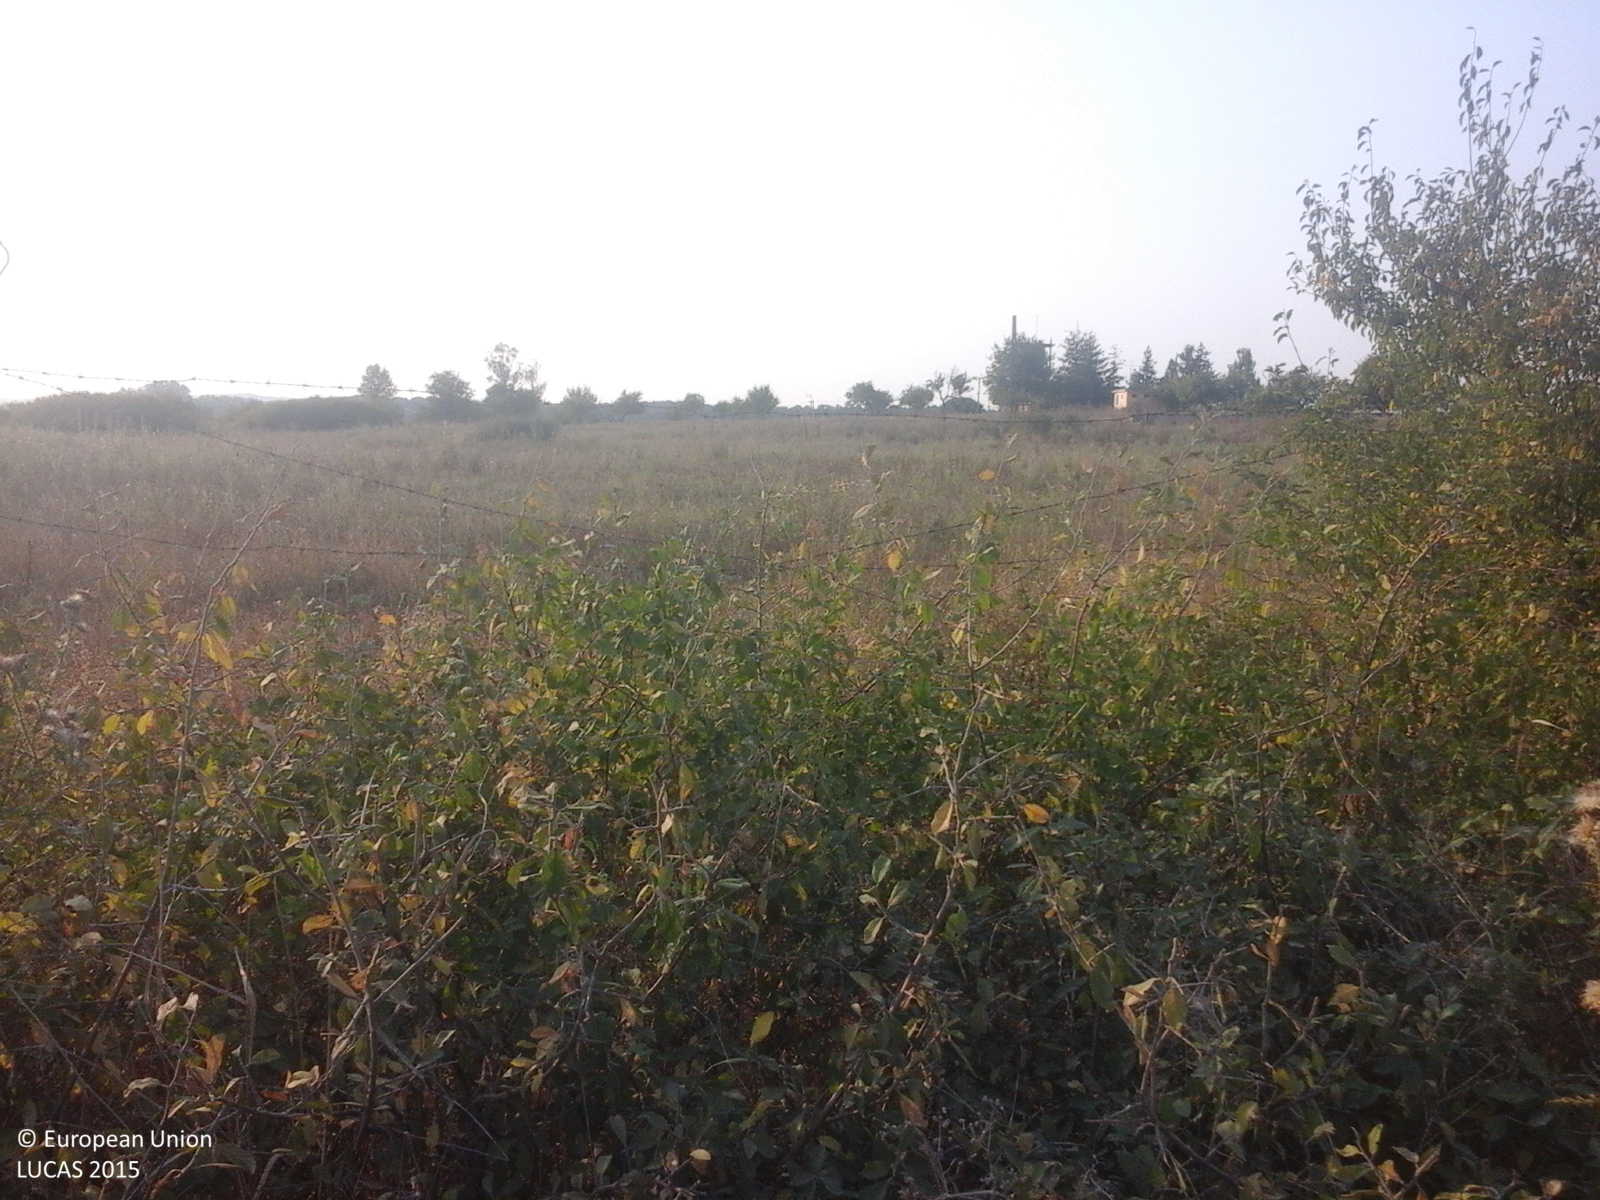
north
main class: Grassland
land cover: Spontaneously vegetated surfaces
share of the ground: > 75 %
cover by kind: herbaceous plants 100 %
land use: Agriculture (excluding fallow land and kitchen gardens)
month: August
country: RO
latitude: 44.3274
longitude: 23.7370
